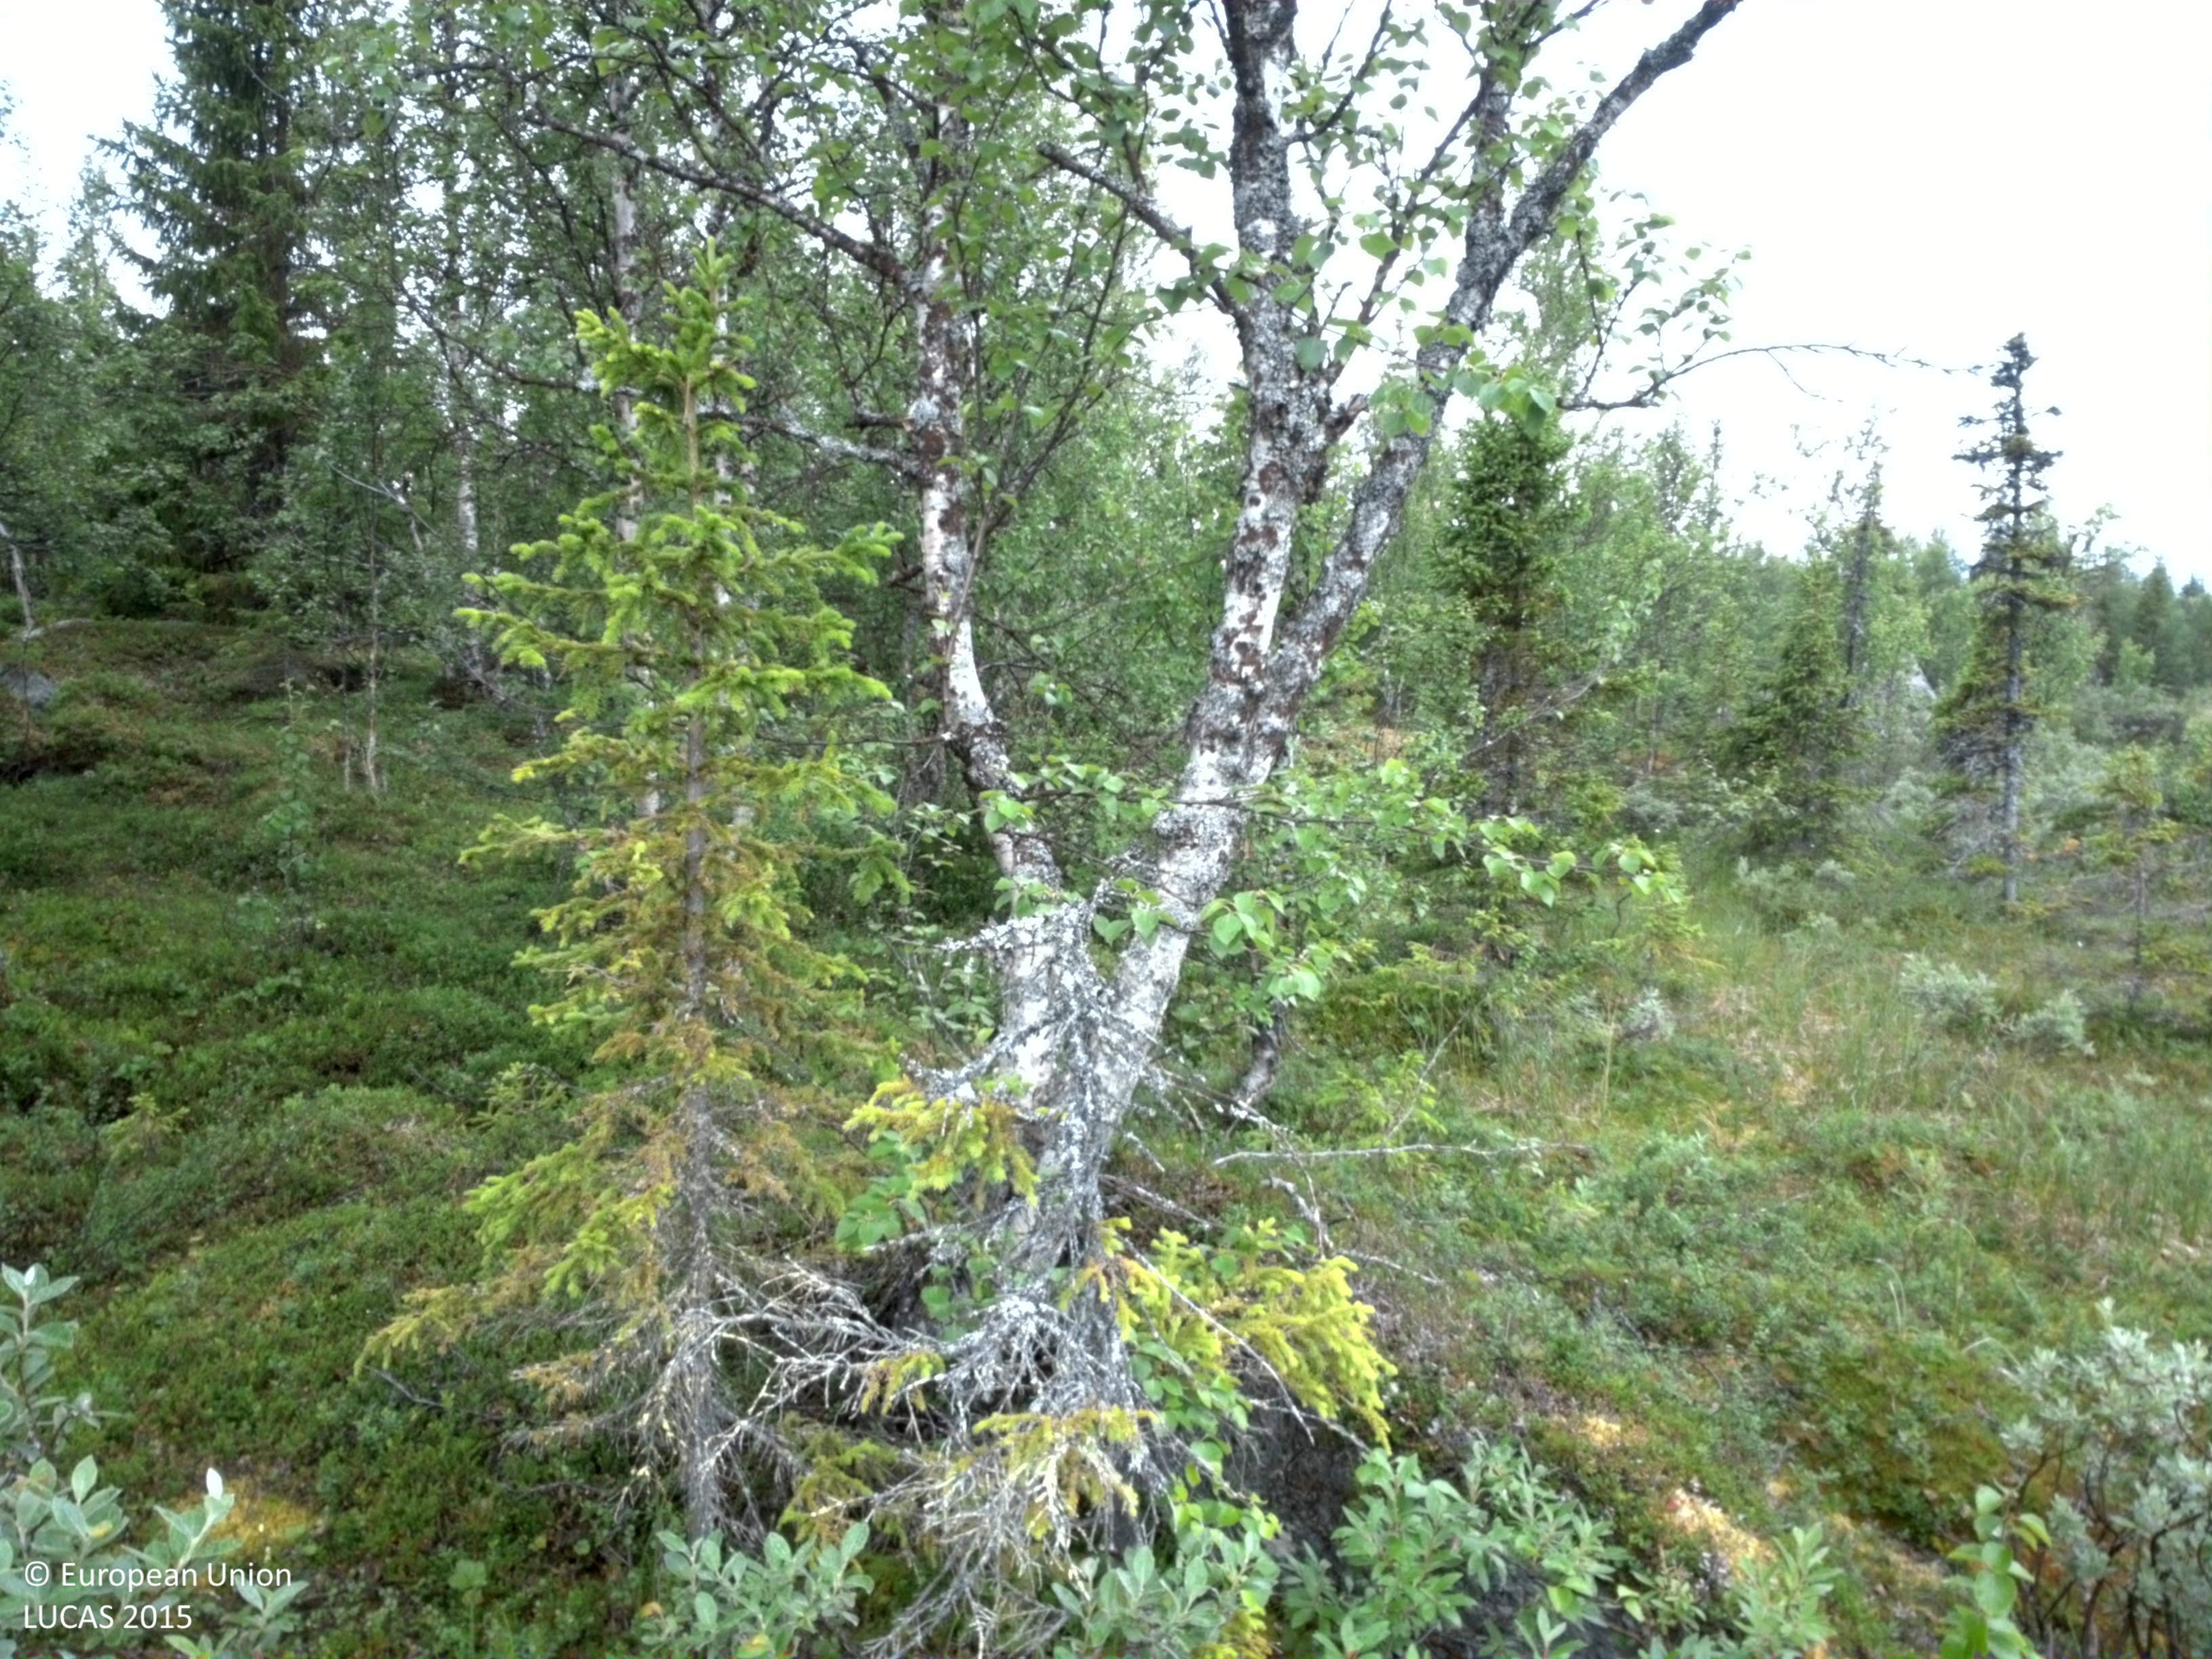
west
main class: Shrubland
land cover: Shrubland with sparse tree cover
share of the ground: > 75 %
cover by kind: shrubs 75 %, herbaceous plants 10 %, lichens and mosses 10 %, coniferous forest trees 5 %
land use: Semi-natural and natural areas not in use
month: August
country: SE
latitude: 64.9909
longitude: 15.5005
